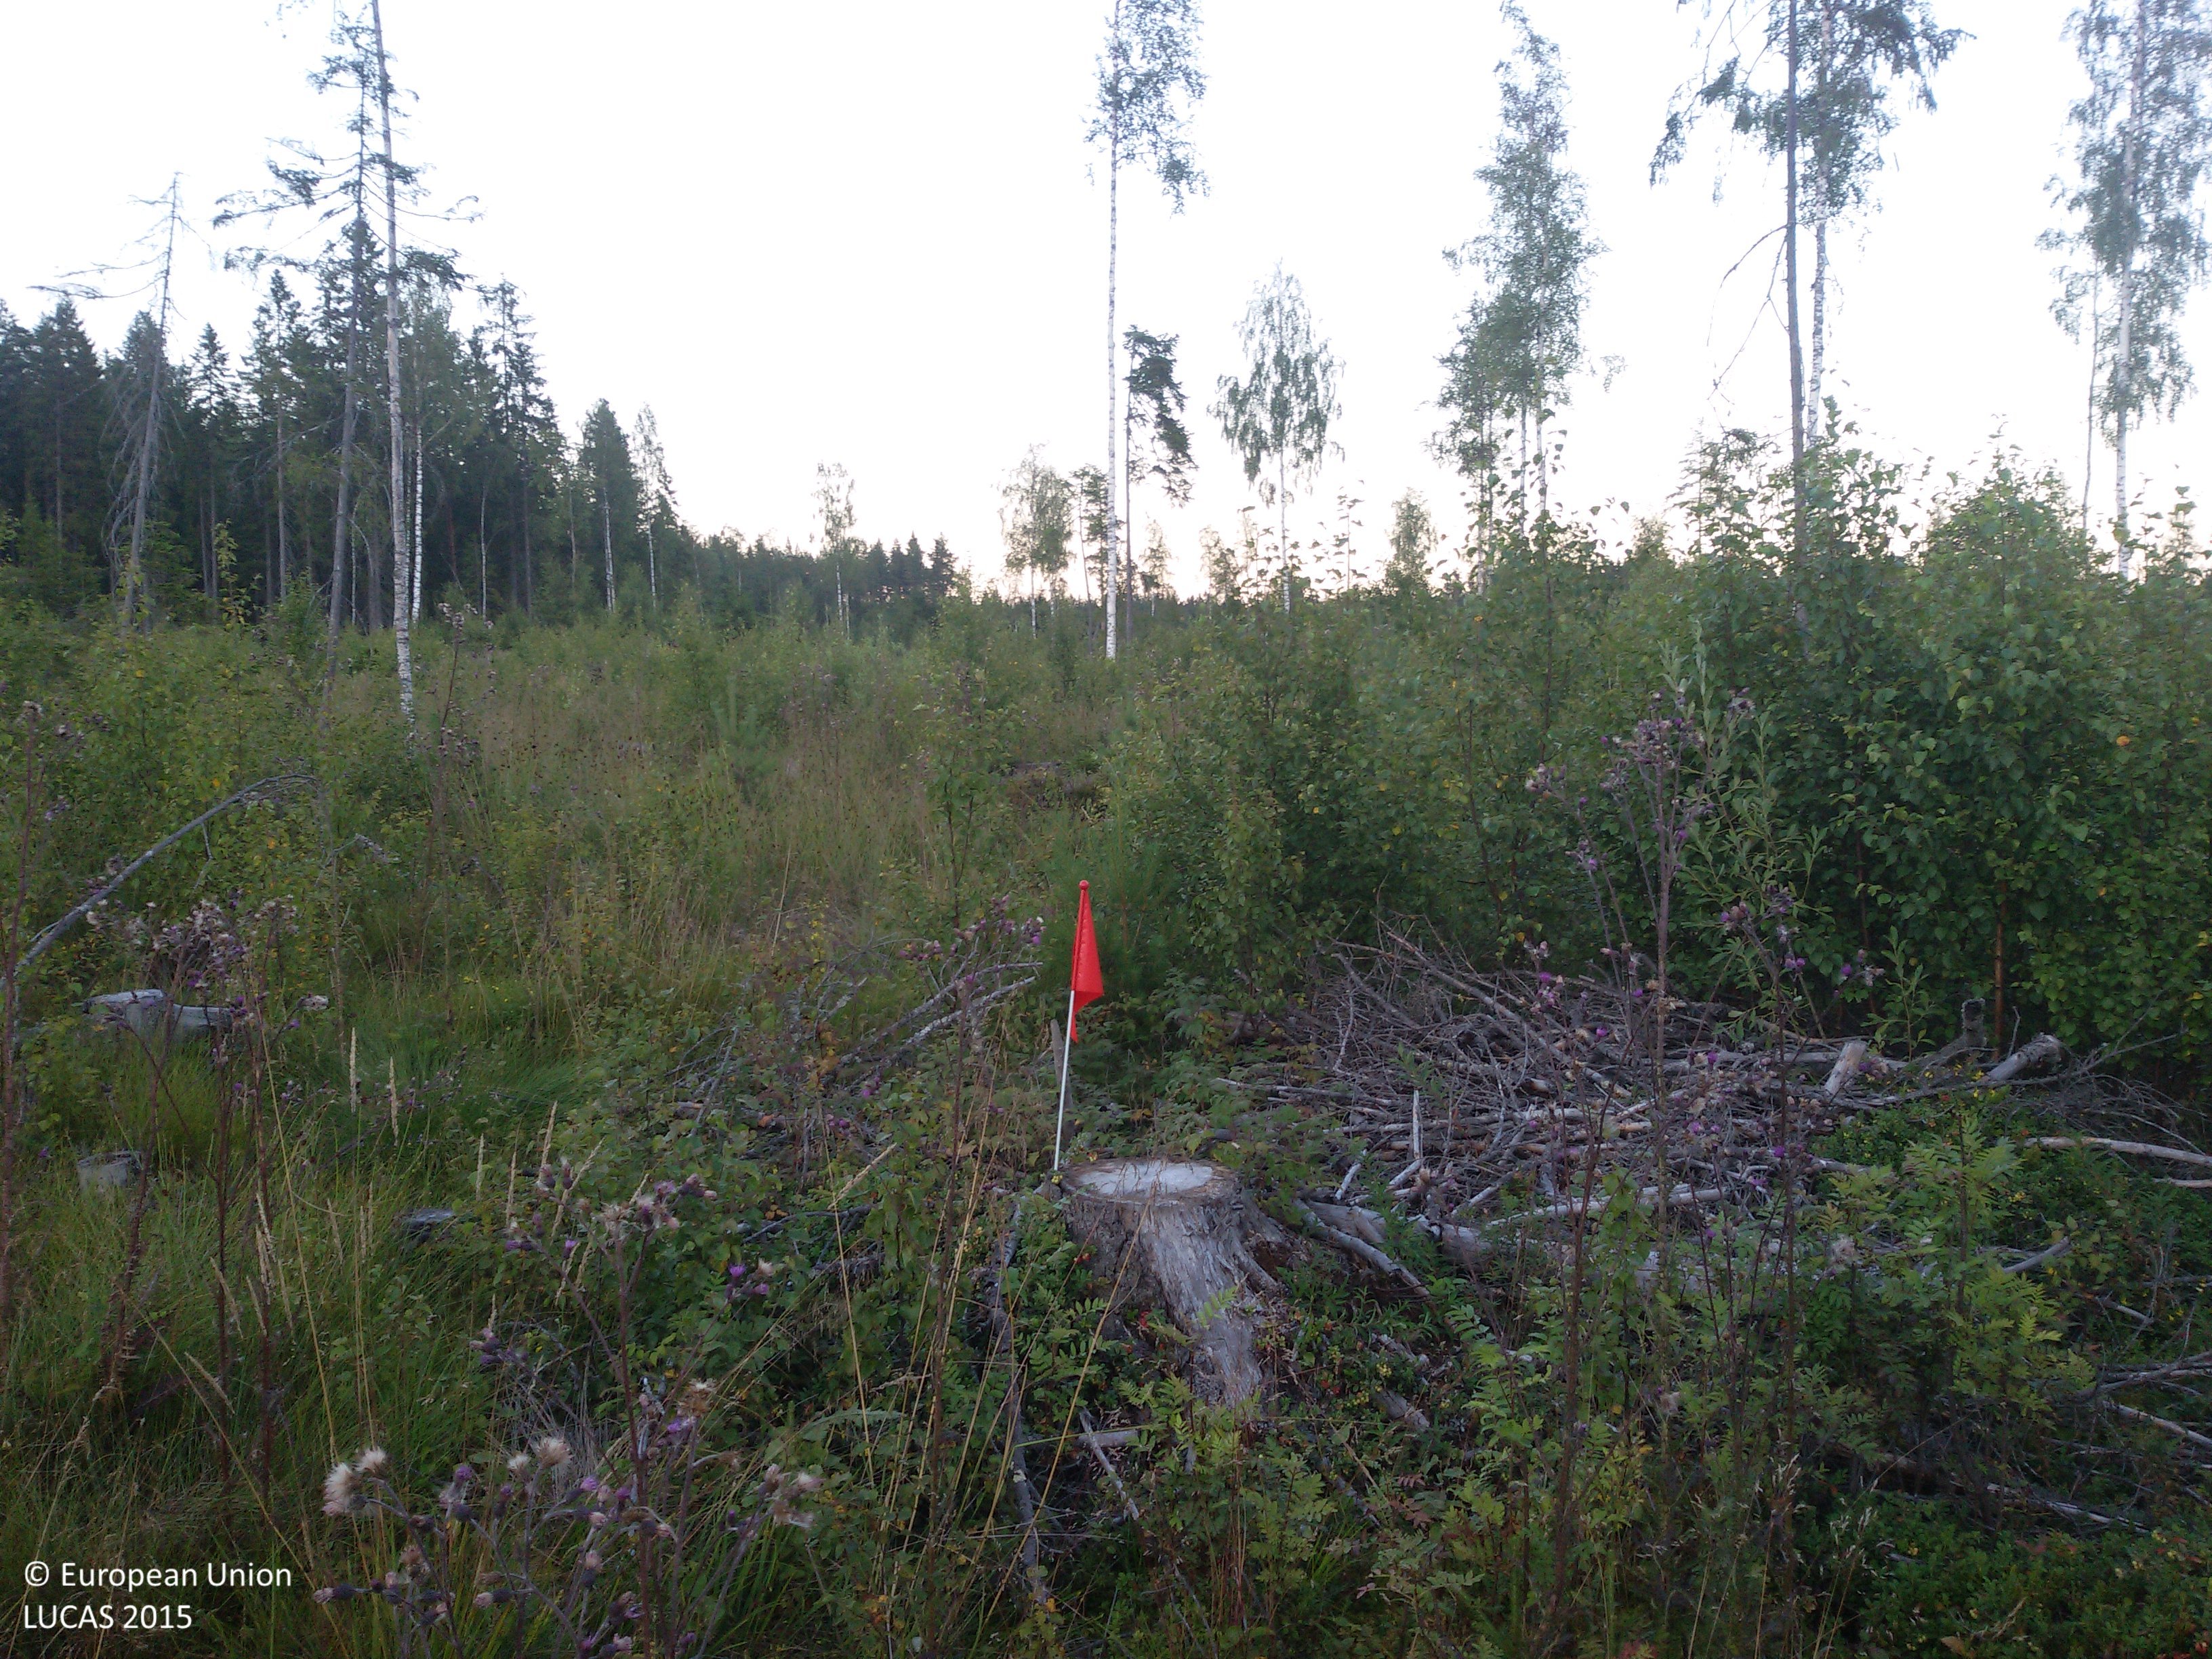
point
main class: Woodland
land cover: Broadleaved woodland
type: boreal forest
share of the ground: 50 - 75 %
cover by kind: broadleaved forest trees 50 %, herbaceous plants 40 %, coniferous forest trees 10 %
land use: Forestry
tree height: < 5 m
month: August
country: SE
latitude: 60.6412
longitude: 16.5890
